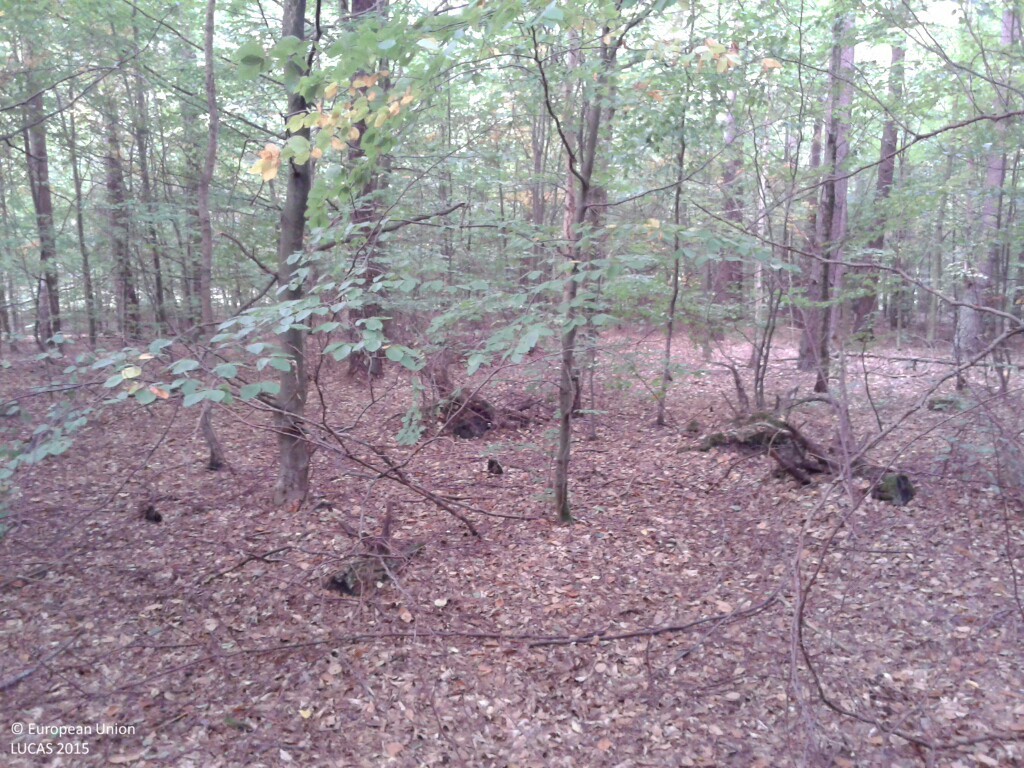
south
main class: Woodland
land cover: Other mixed woodland
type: acidophilous oak and oak-birch forest
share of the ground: > 75 %
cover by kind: broadleaved forest trees 60 %, coniferous forest trees 30 %, unconsolidated bare surface 10 %
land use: Forestry
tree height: > 5 m
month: September
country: PL
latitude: 53.6955
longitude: 20.1960
